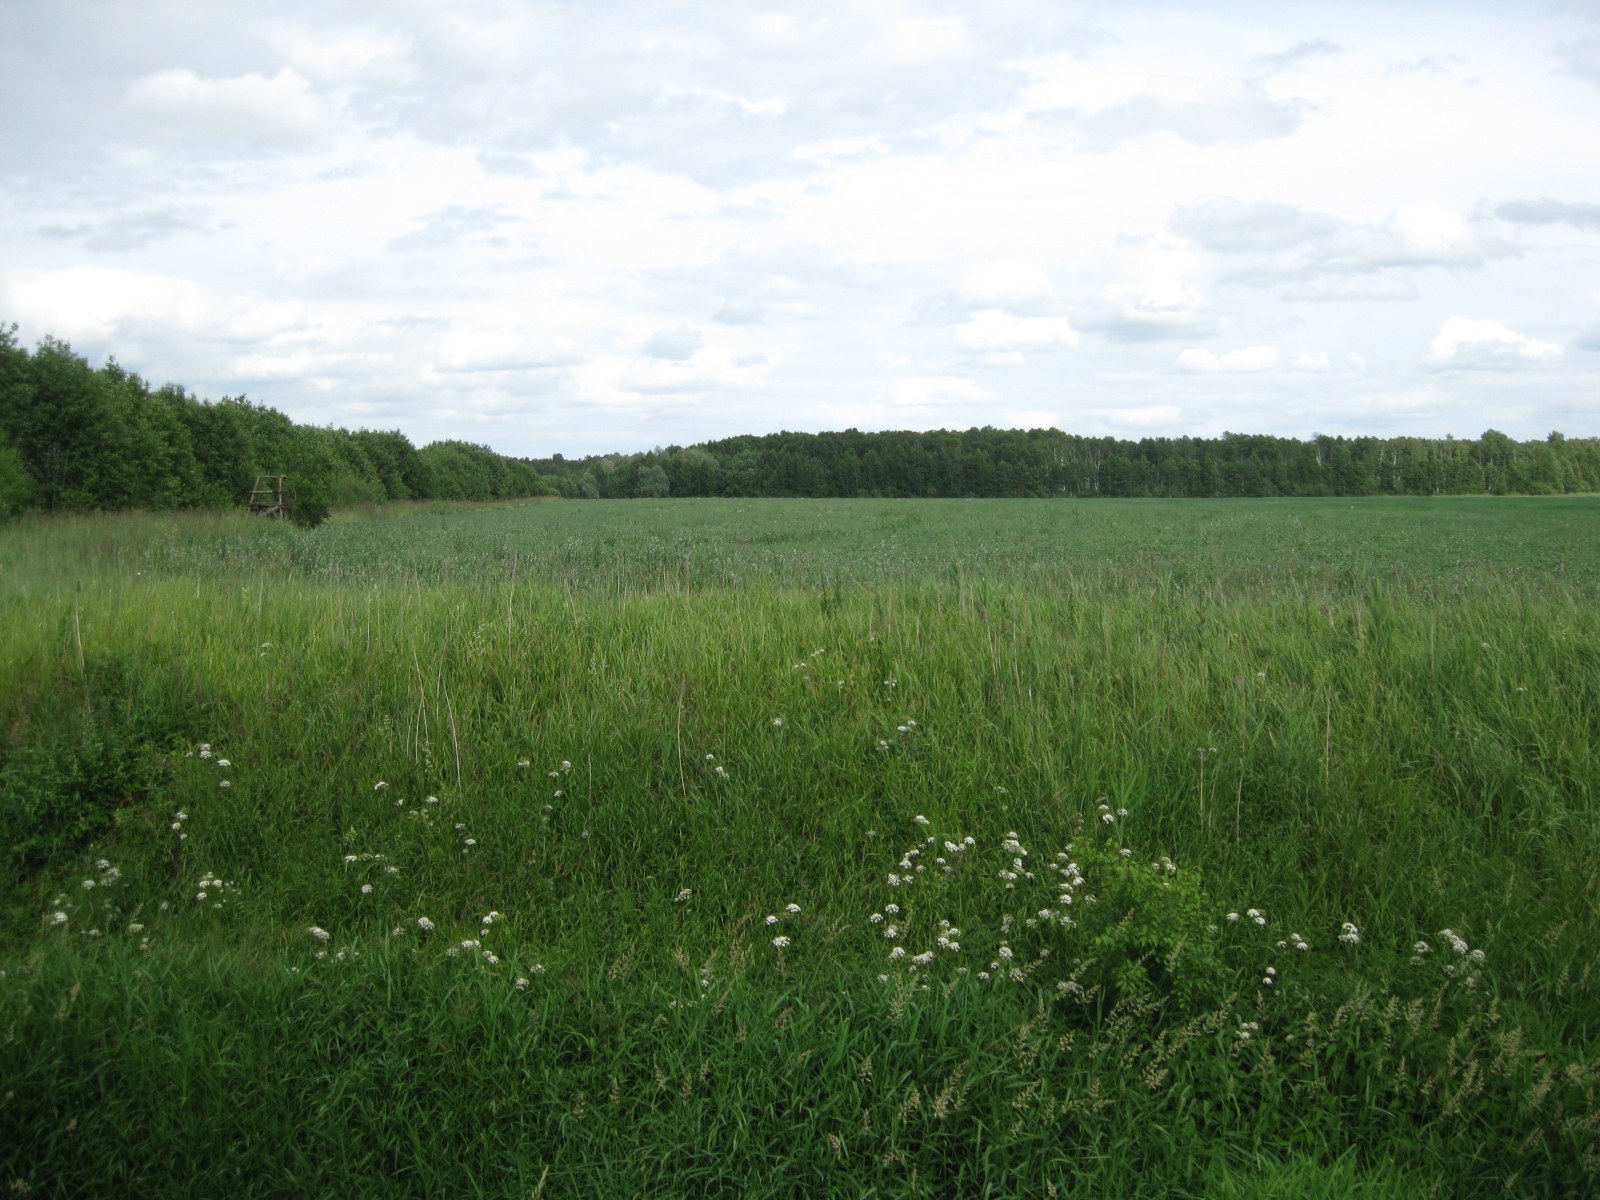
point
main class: Cropland
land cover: Dry pulses
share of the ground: > 75 %
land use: Agriculture (excluding fallow land and kitchen gardens)
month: June
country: LT
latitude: 55.5478
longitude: 24.2807
